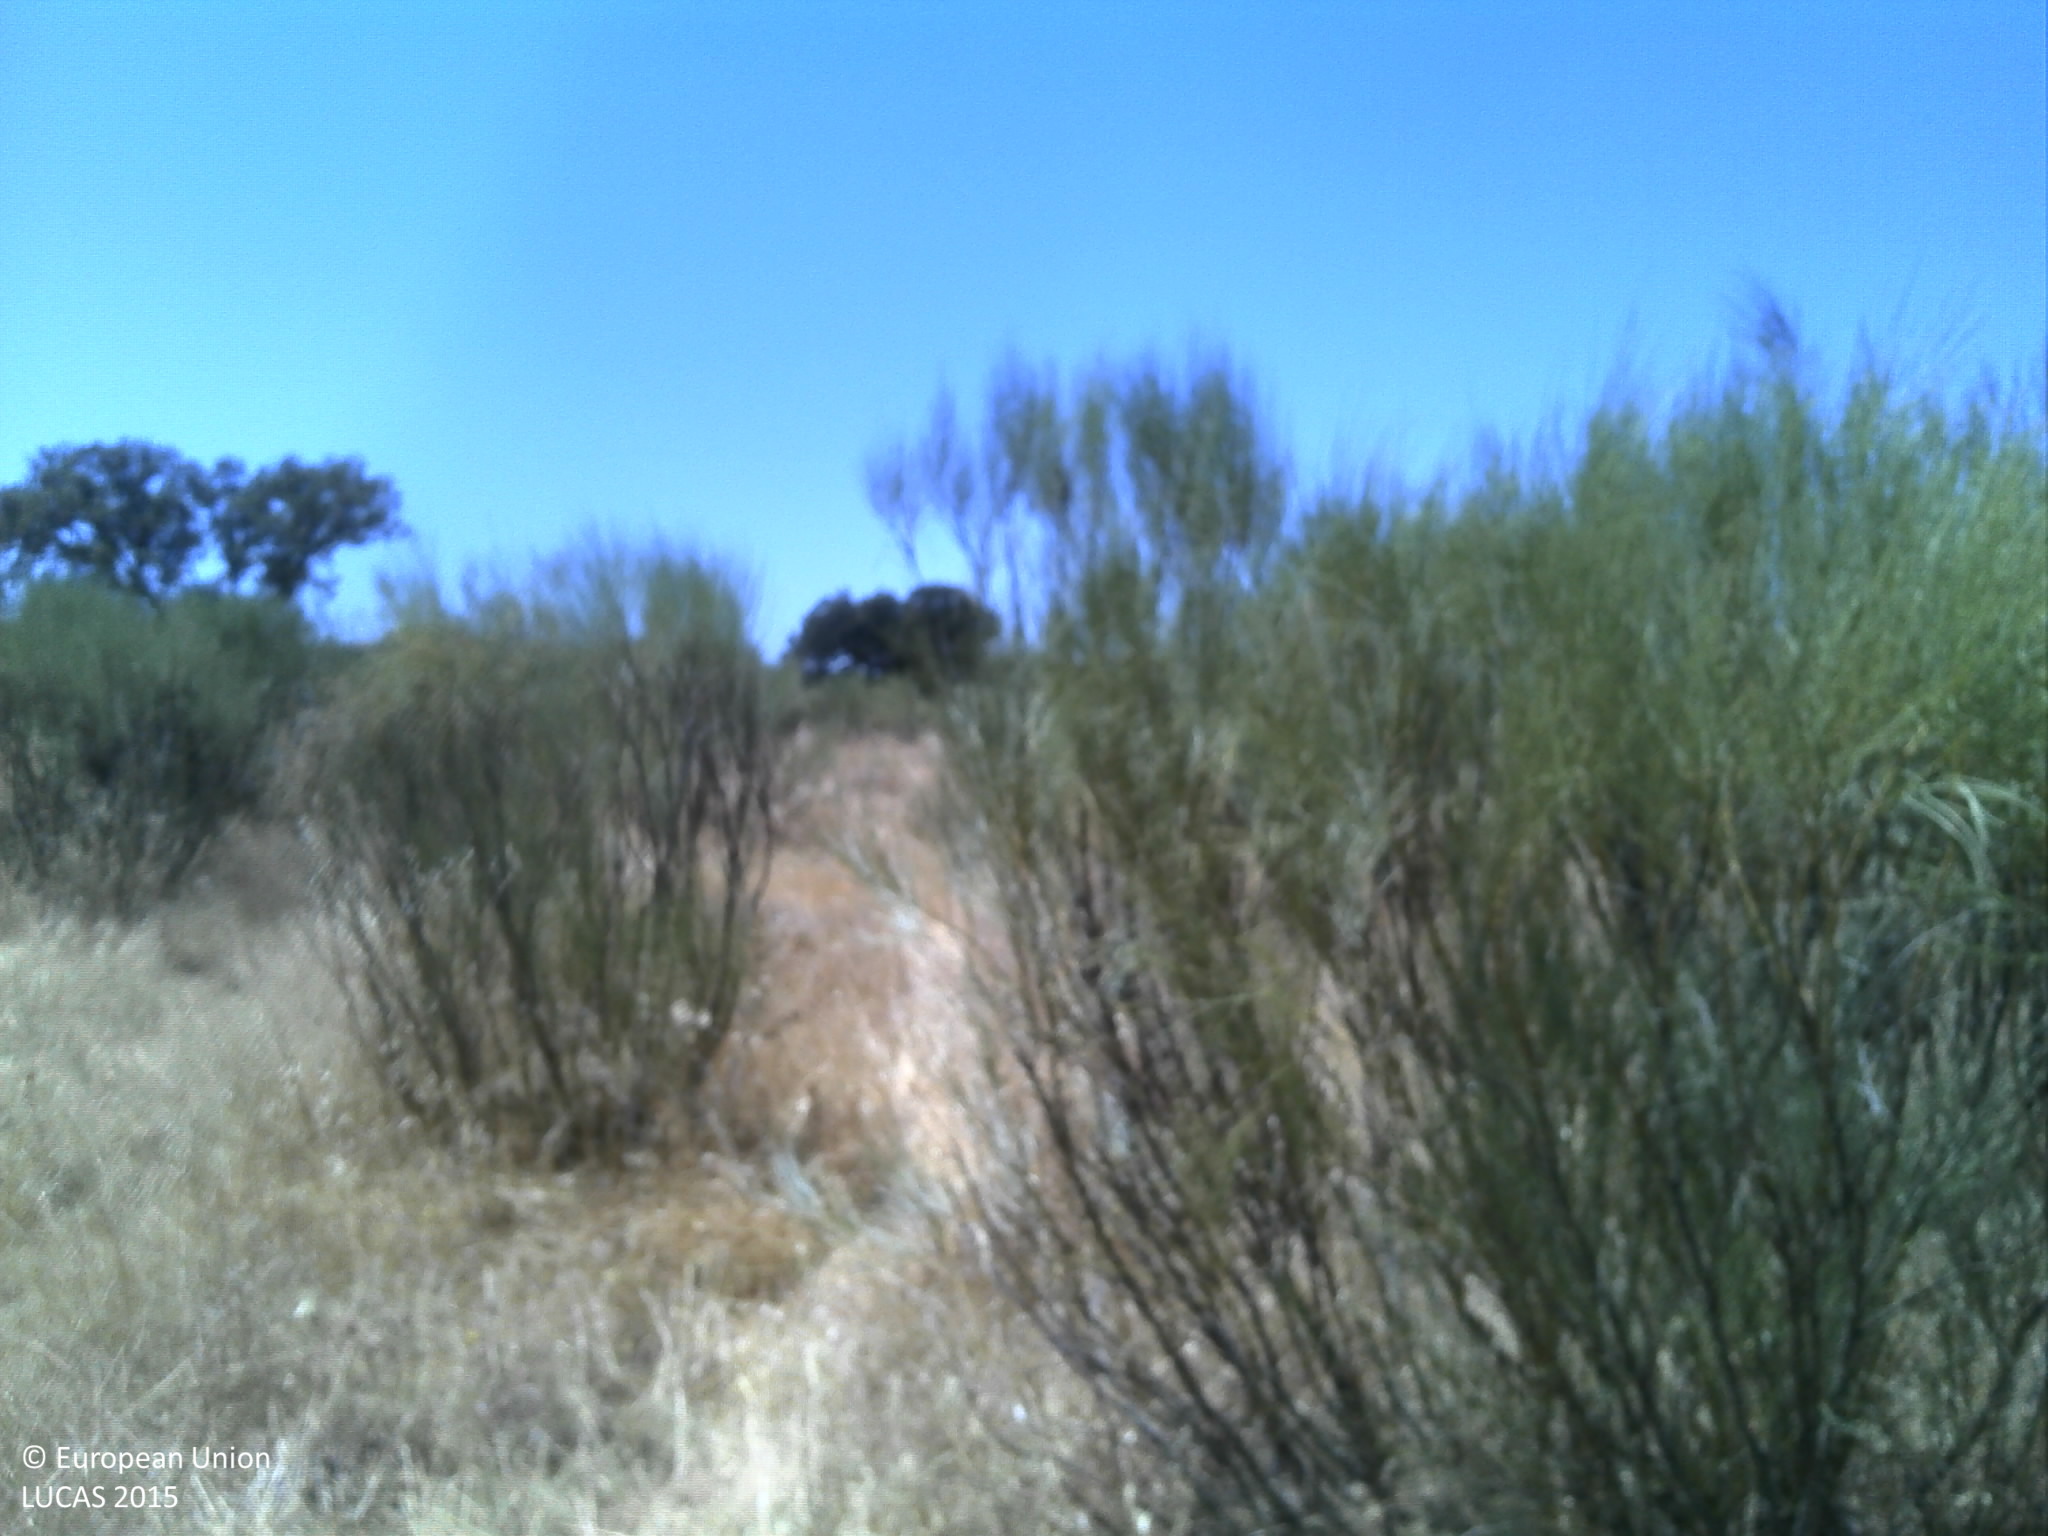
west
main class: Shrubland
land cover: Shrubland without tree cover
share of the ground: 25 - 50 %
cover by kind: herbaceous plants 50 %, shrubs 25 %, unconsolidated bare surface 25 %
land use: Agriculture (excluding fallow land and kitchen gardens)
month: July
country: PT
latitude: 38.9884
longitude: -7.1270
